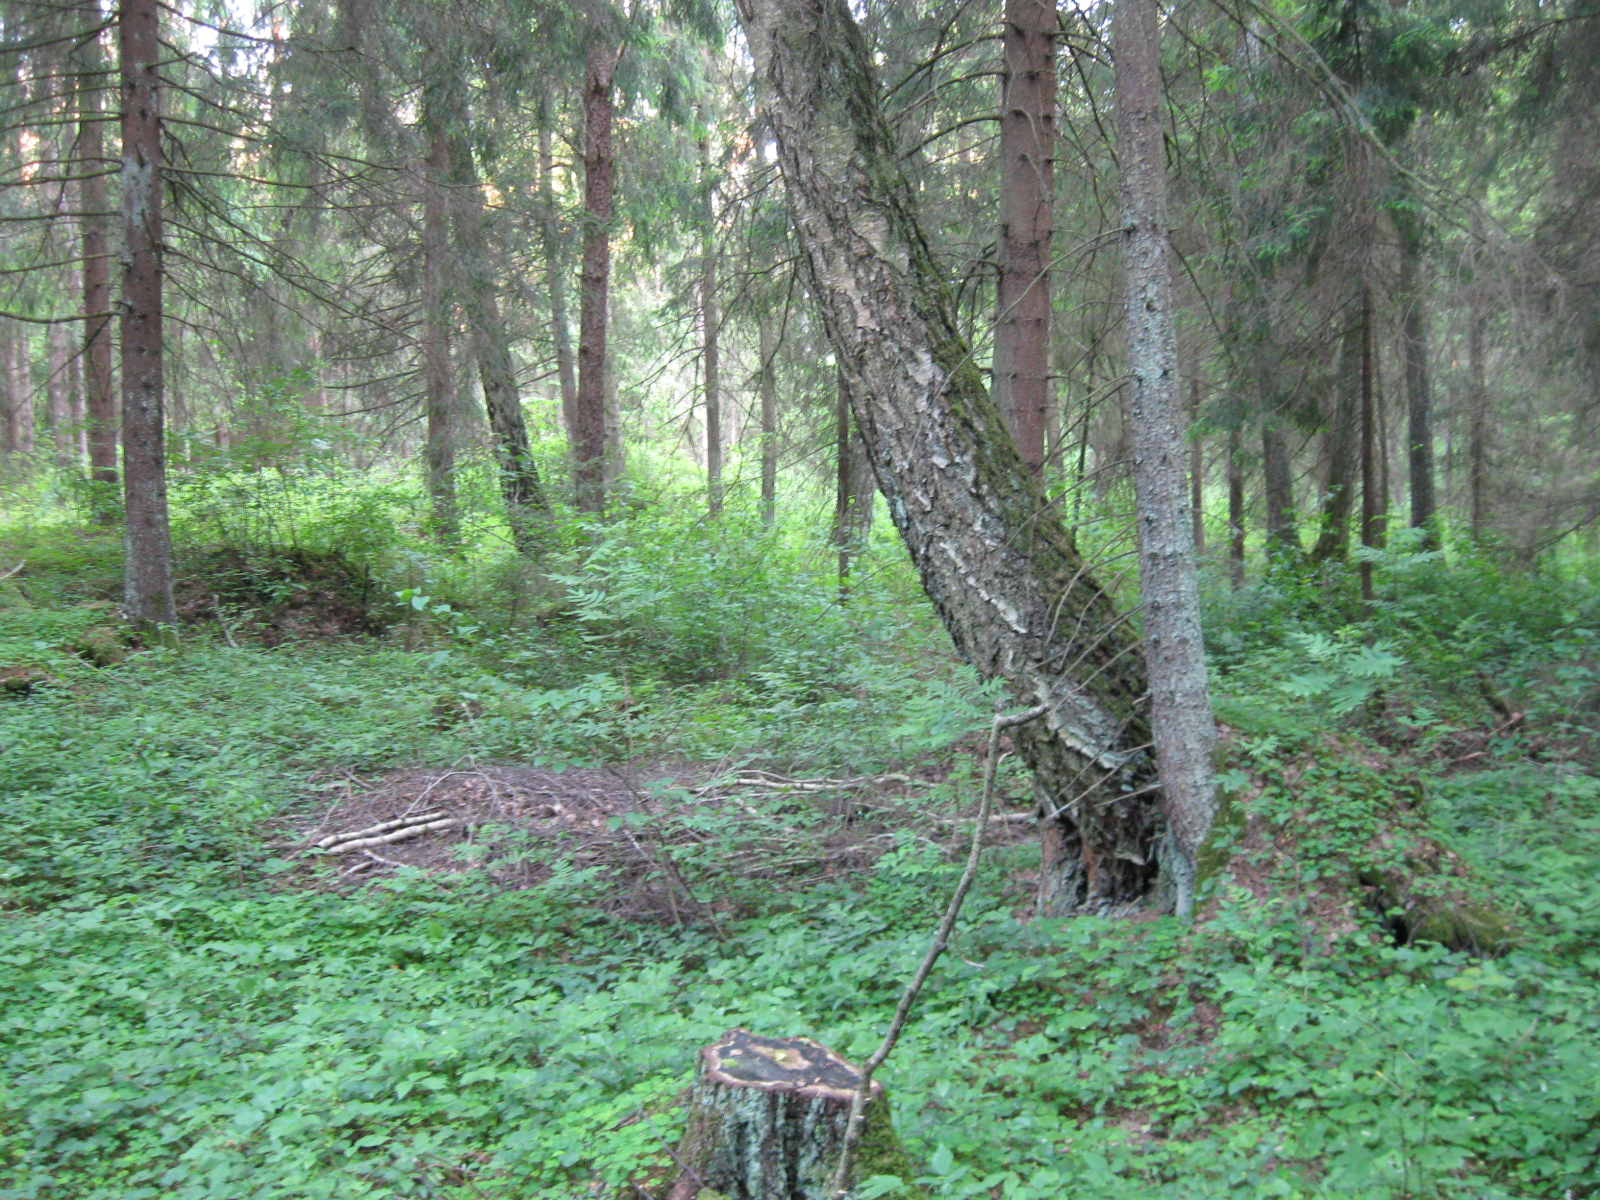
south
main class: Woodland
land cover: Spruce dominated mixed woodland
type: hemiboreal forest and nemoral coniferous forest and mixed broadleaved-coniferous forest
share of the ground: > 75 %
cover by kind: coniferous forest trees 70 %, broadleaved forest trees 30 %
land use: Forestry
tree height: > 5 m
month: June
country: LT
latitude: 54.1518
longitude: 23.6984
